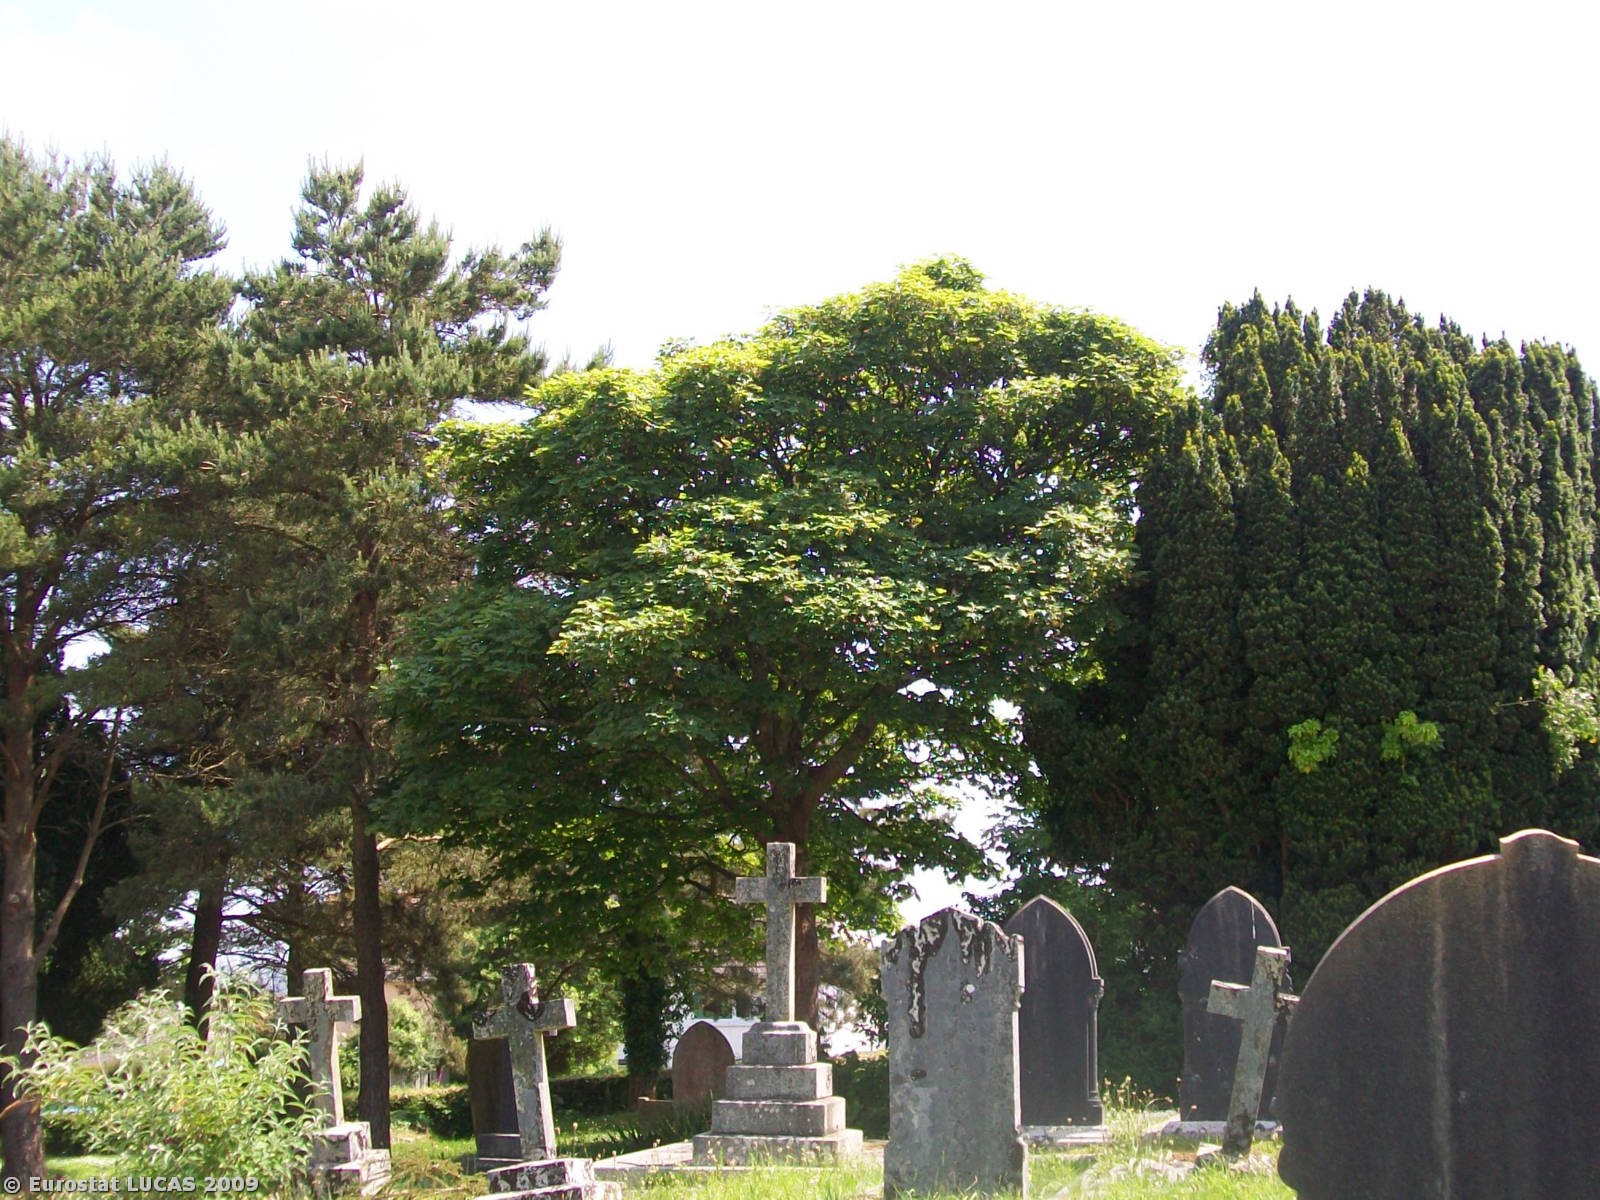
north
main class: Grassland
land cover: Grassland with sparse tree/shrub cover
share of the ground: > 75 %
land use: Community services
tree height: > 5 m
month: June
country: GB
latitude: 50.1440
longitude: -5.0757
